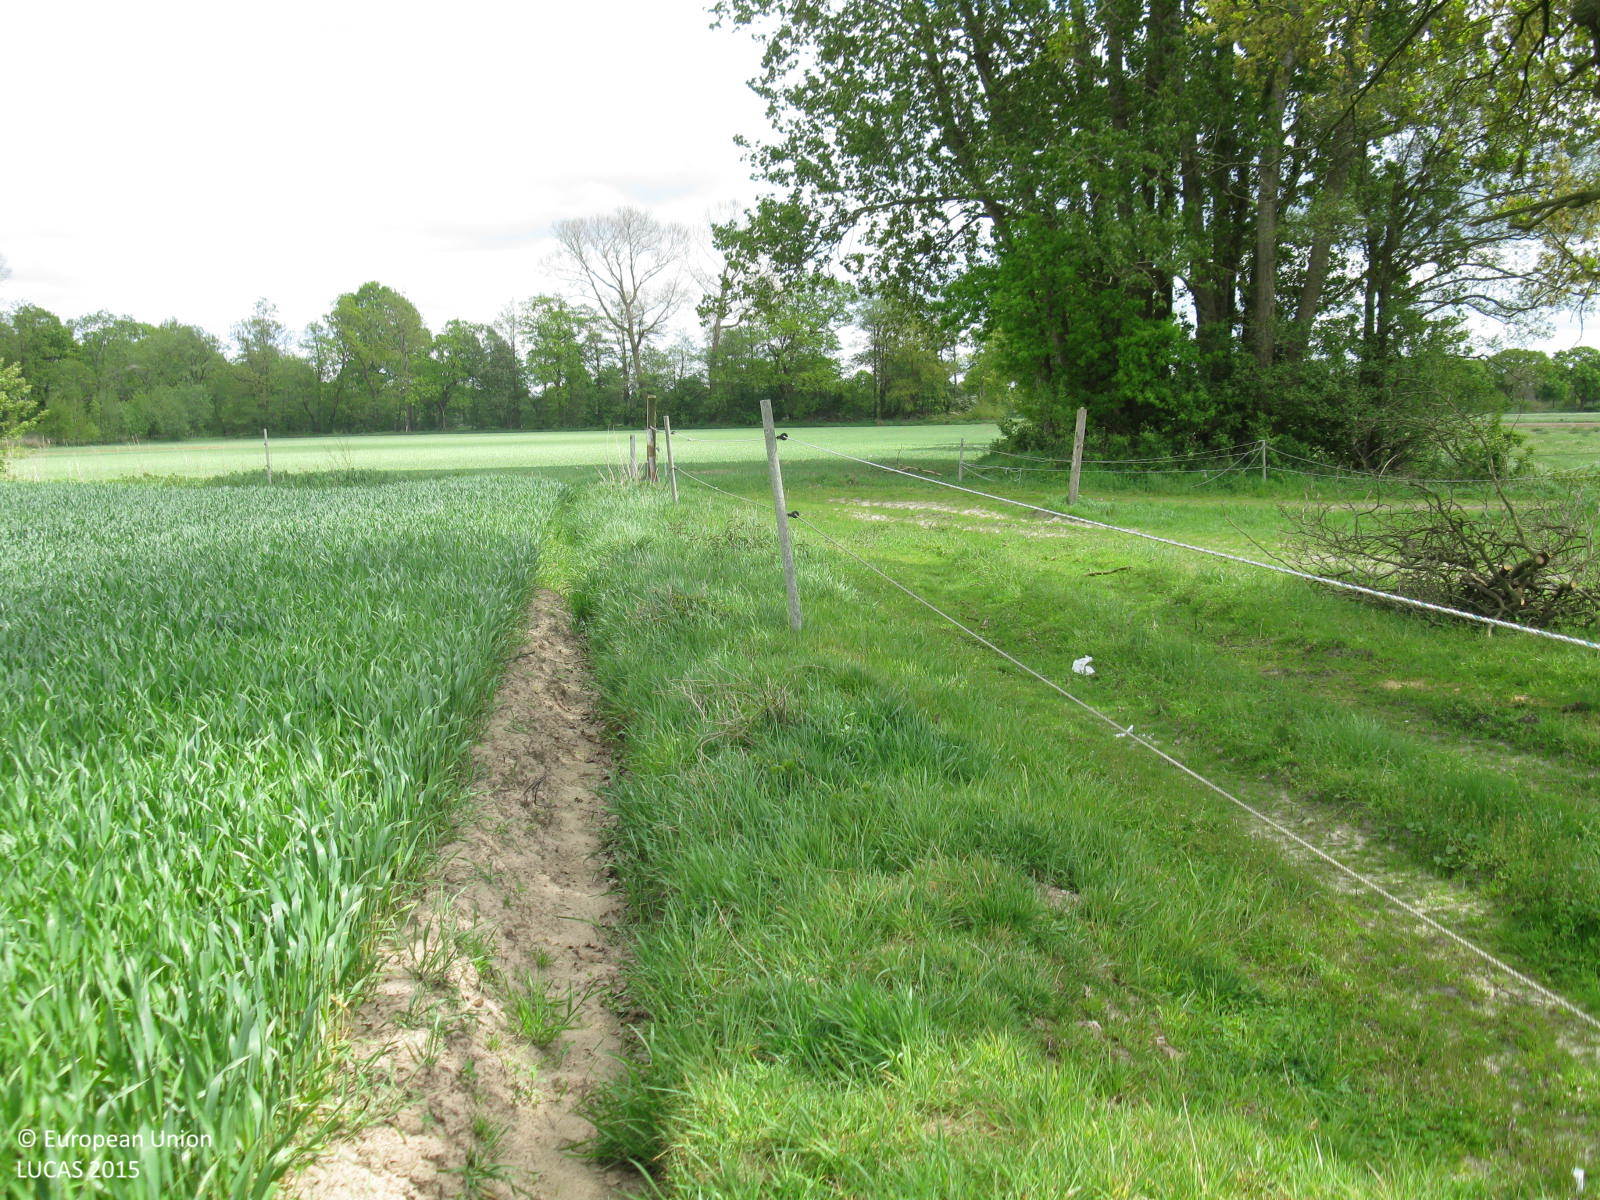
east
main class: Cropland
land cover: Triticale
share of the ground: > 75 %
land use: Agriculture (excluding fallow land and kitchen gardens)
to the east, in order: Triticale; Tracks; Fences; Oats; Broadleaved woodland; Ditches and canals; Grass margins; Fences; Grassland without tree/shrub cover
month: May
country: DE
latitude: 52.9763
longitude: 7.3049
